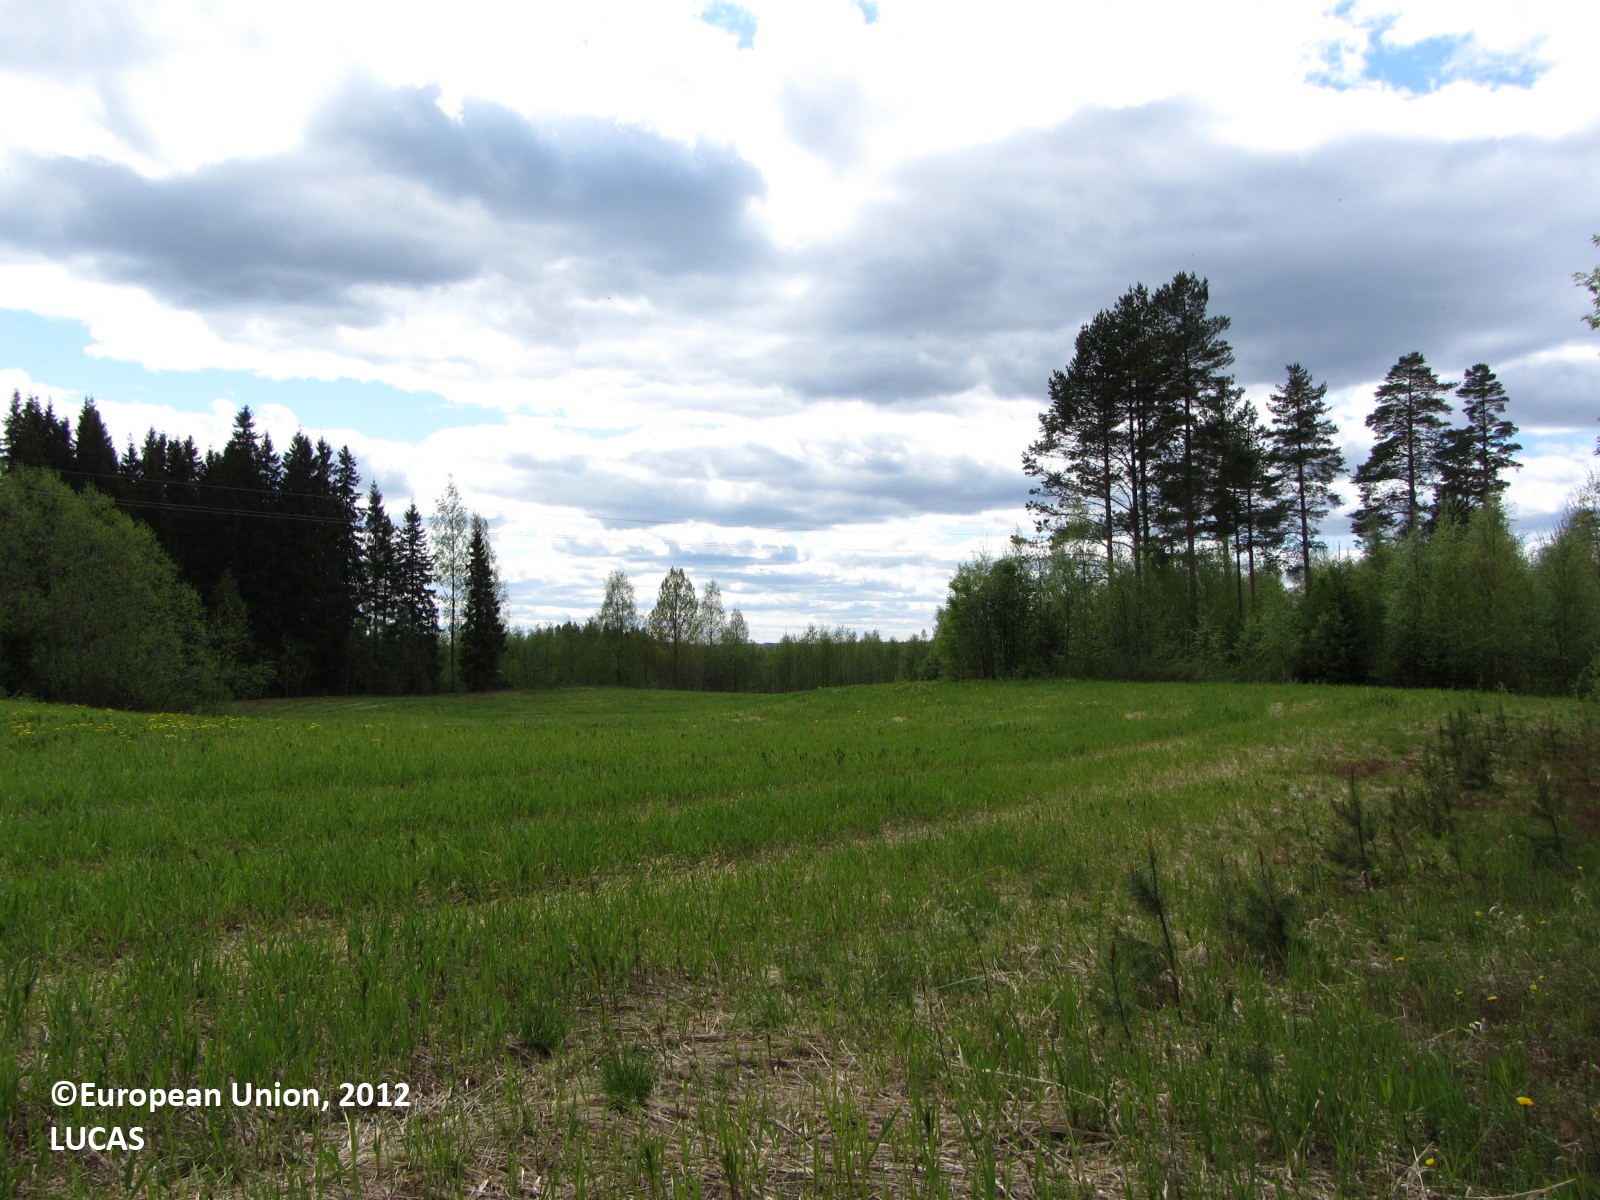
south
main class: Cropland
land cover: Temporary grasslands
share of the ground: > 75 %
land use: Agriculture (excluding fallow land and kitchen gardens)
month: May
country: FI
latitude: 62.4890
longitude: 25.4606
